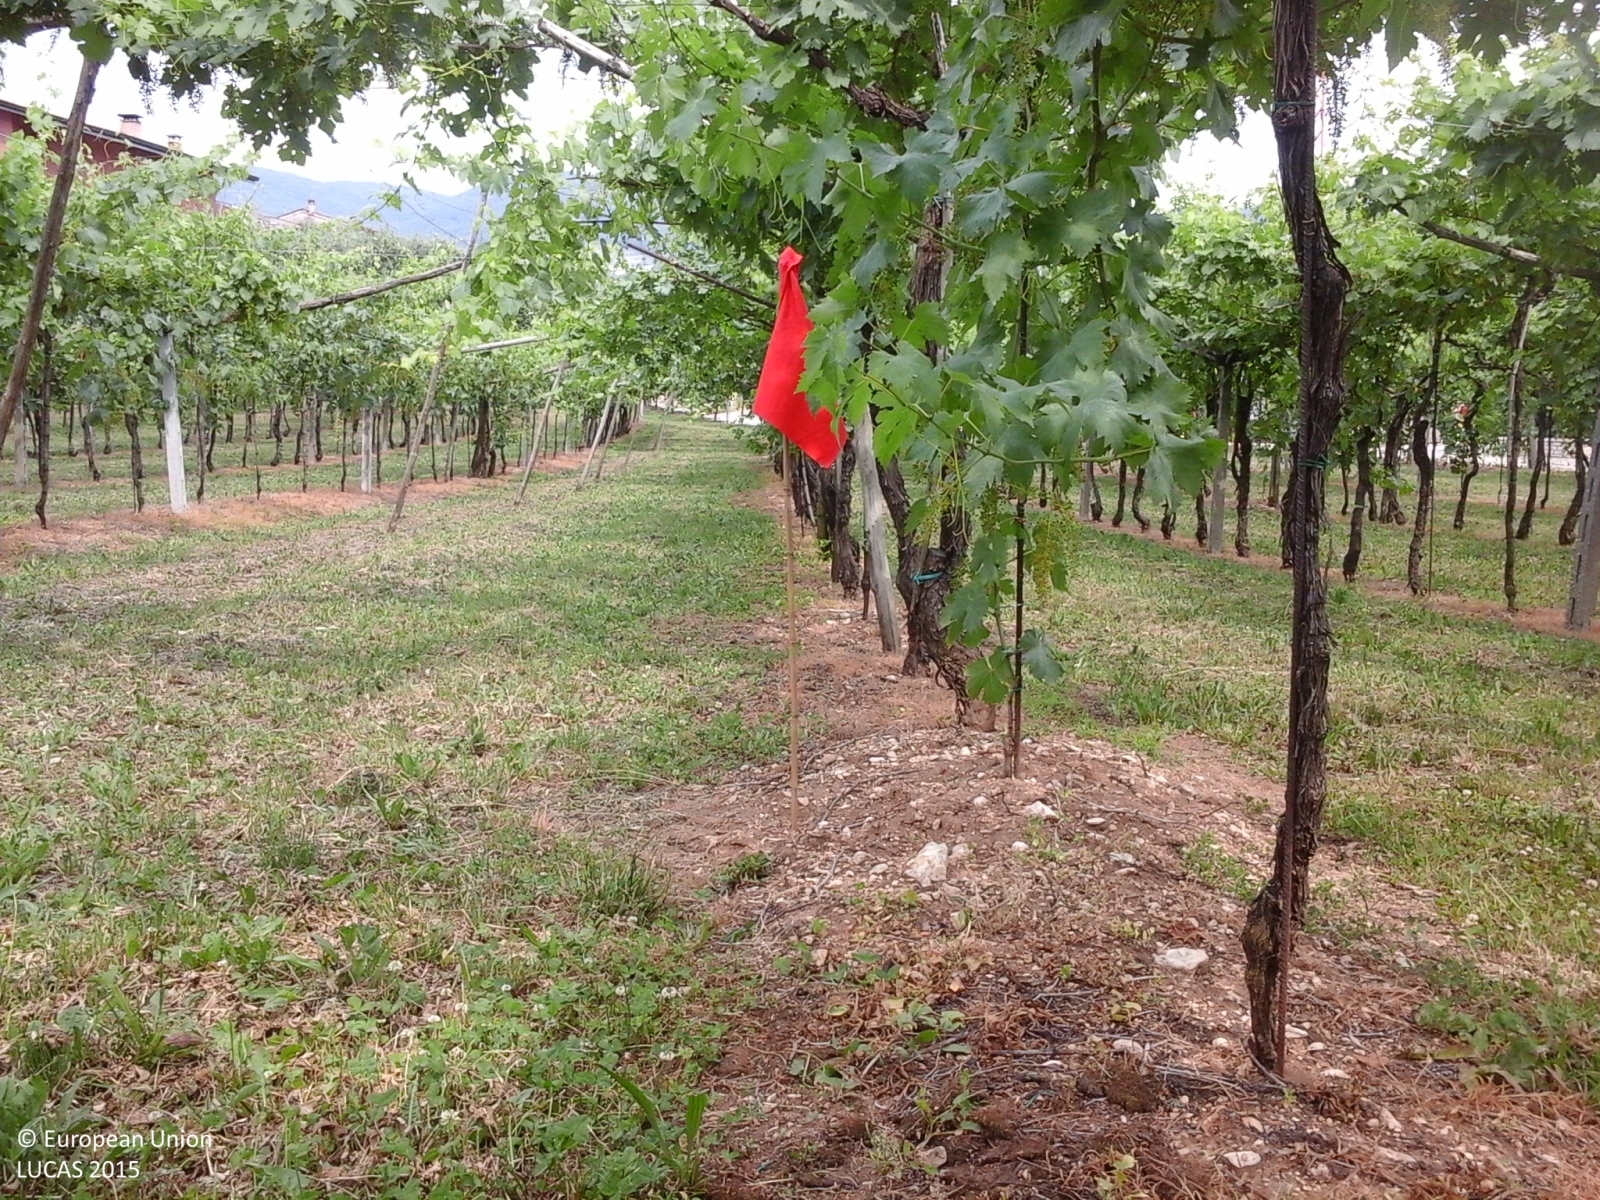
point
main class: Cropland
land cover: Vineyards
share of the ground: > 75 %
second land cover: Grassland without tree/shrub cover
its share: > 75 %
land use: Agriculture (excluding fallow land and kitchen gardens)
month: June
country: IT
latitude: 45.5363
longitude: 10.9333
